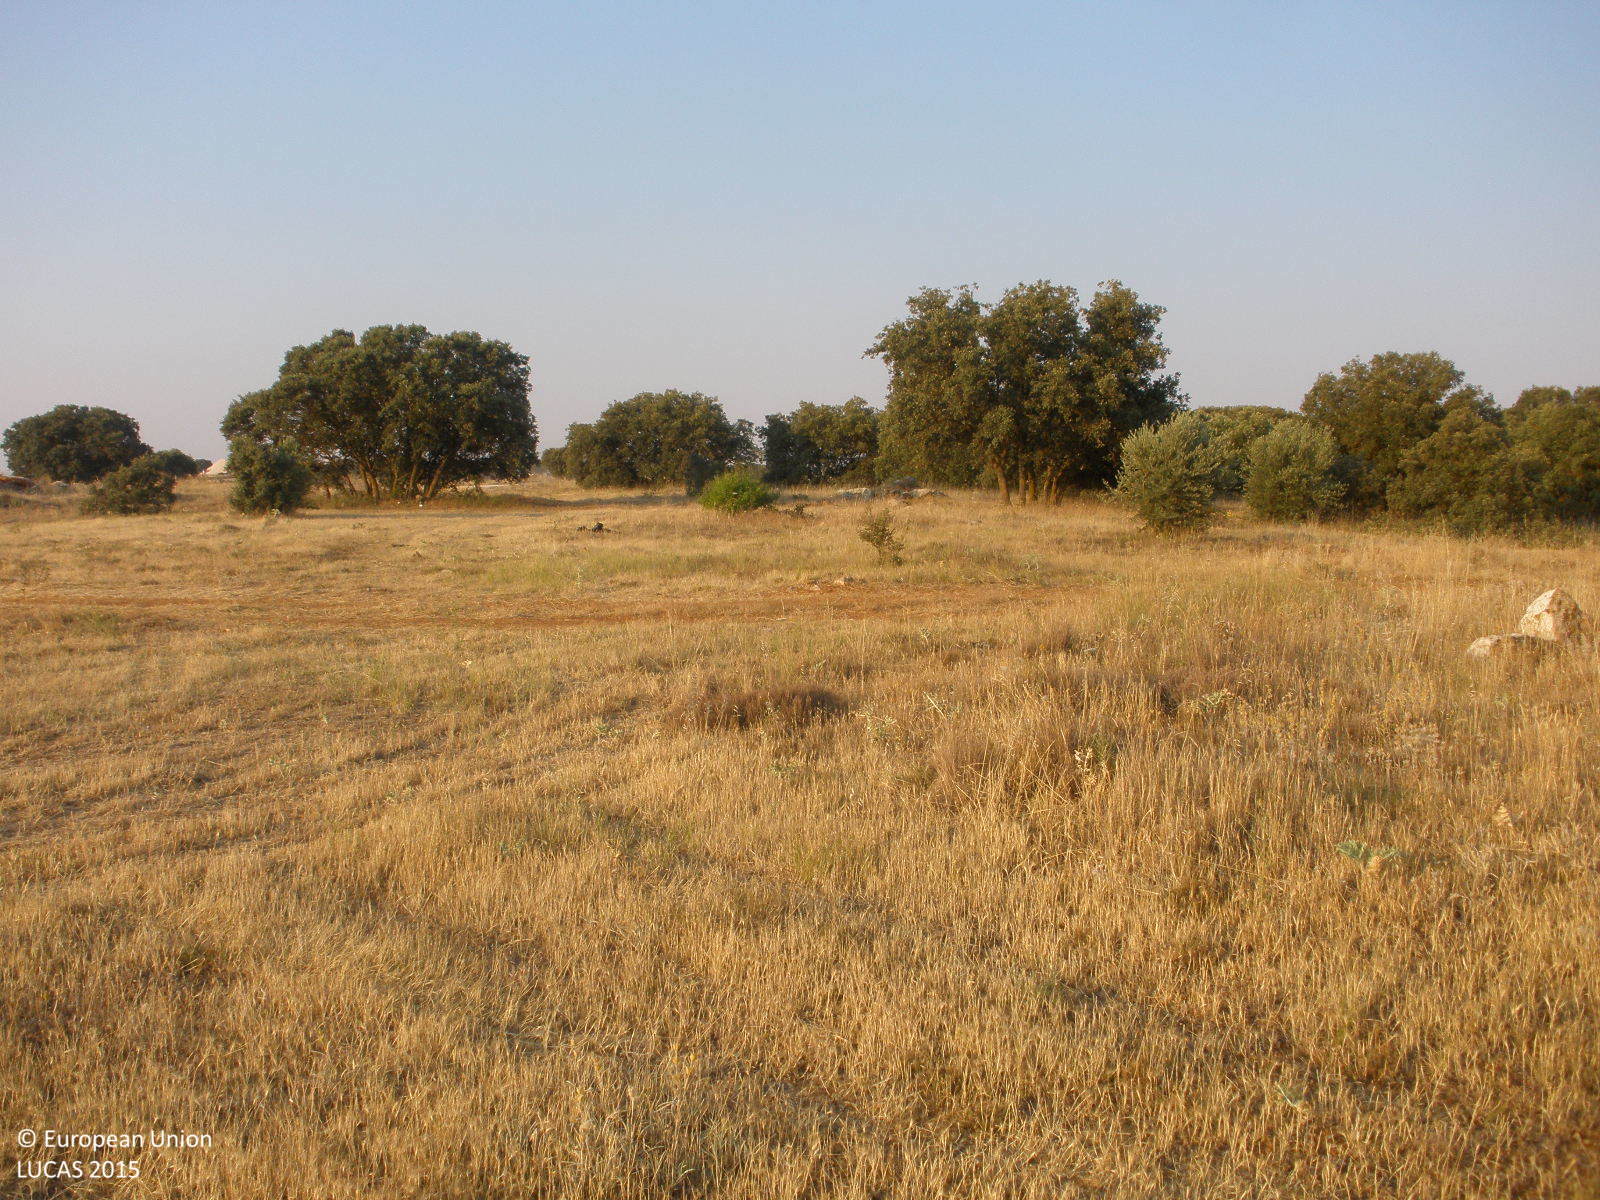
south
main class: Grassland
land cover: Grassland with sparse tree/shrub cover
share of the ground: > 75 %
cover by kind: herbaceous plants 90 %, broadleaved forest trees 5 %, shrubs 5 %
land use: Agriculture (excluding fallow land and kitchen gardens)
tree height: < 5 m
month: June
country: ES
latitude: 40.3282
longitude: -3.2958
